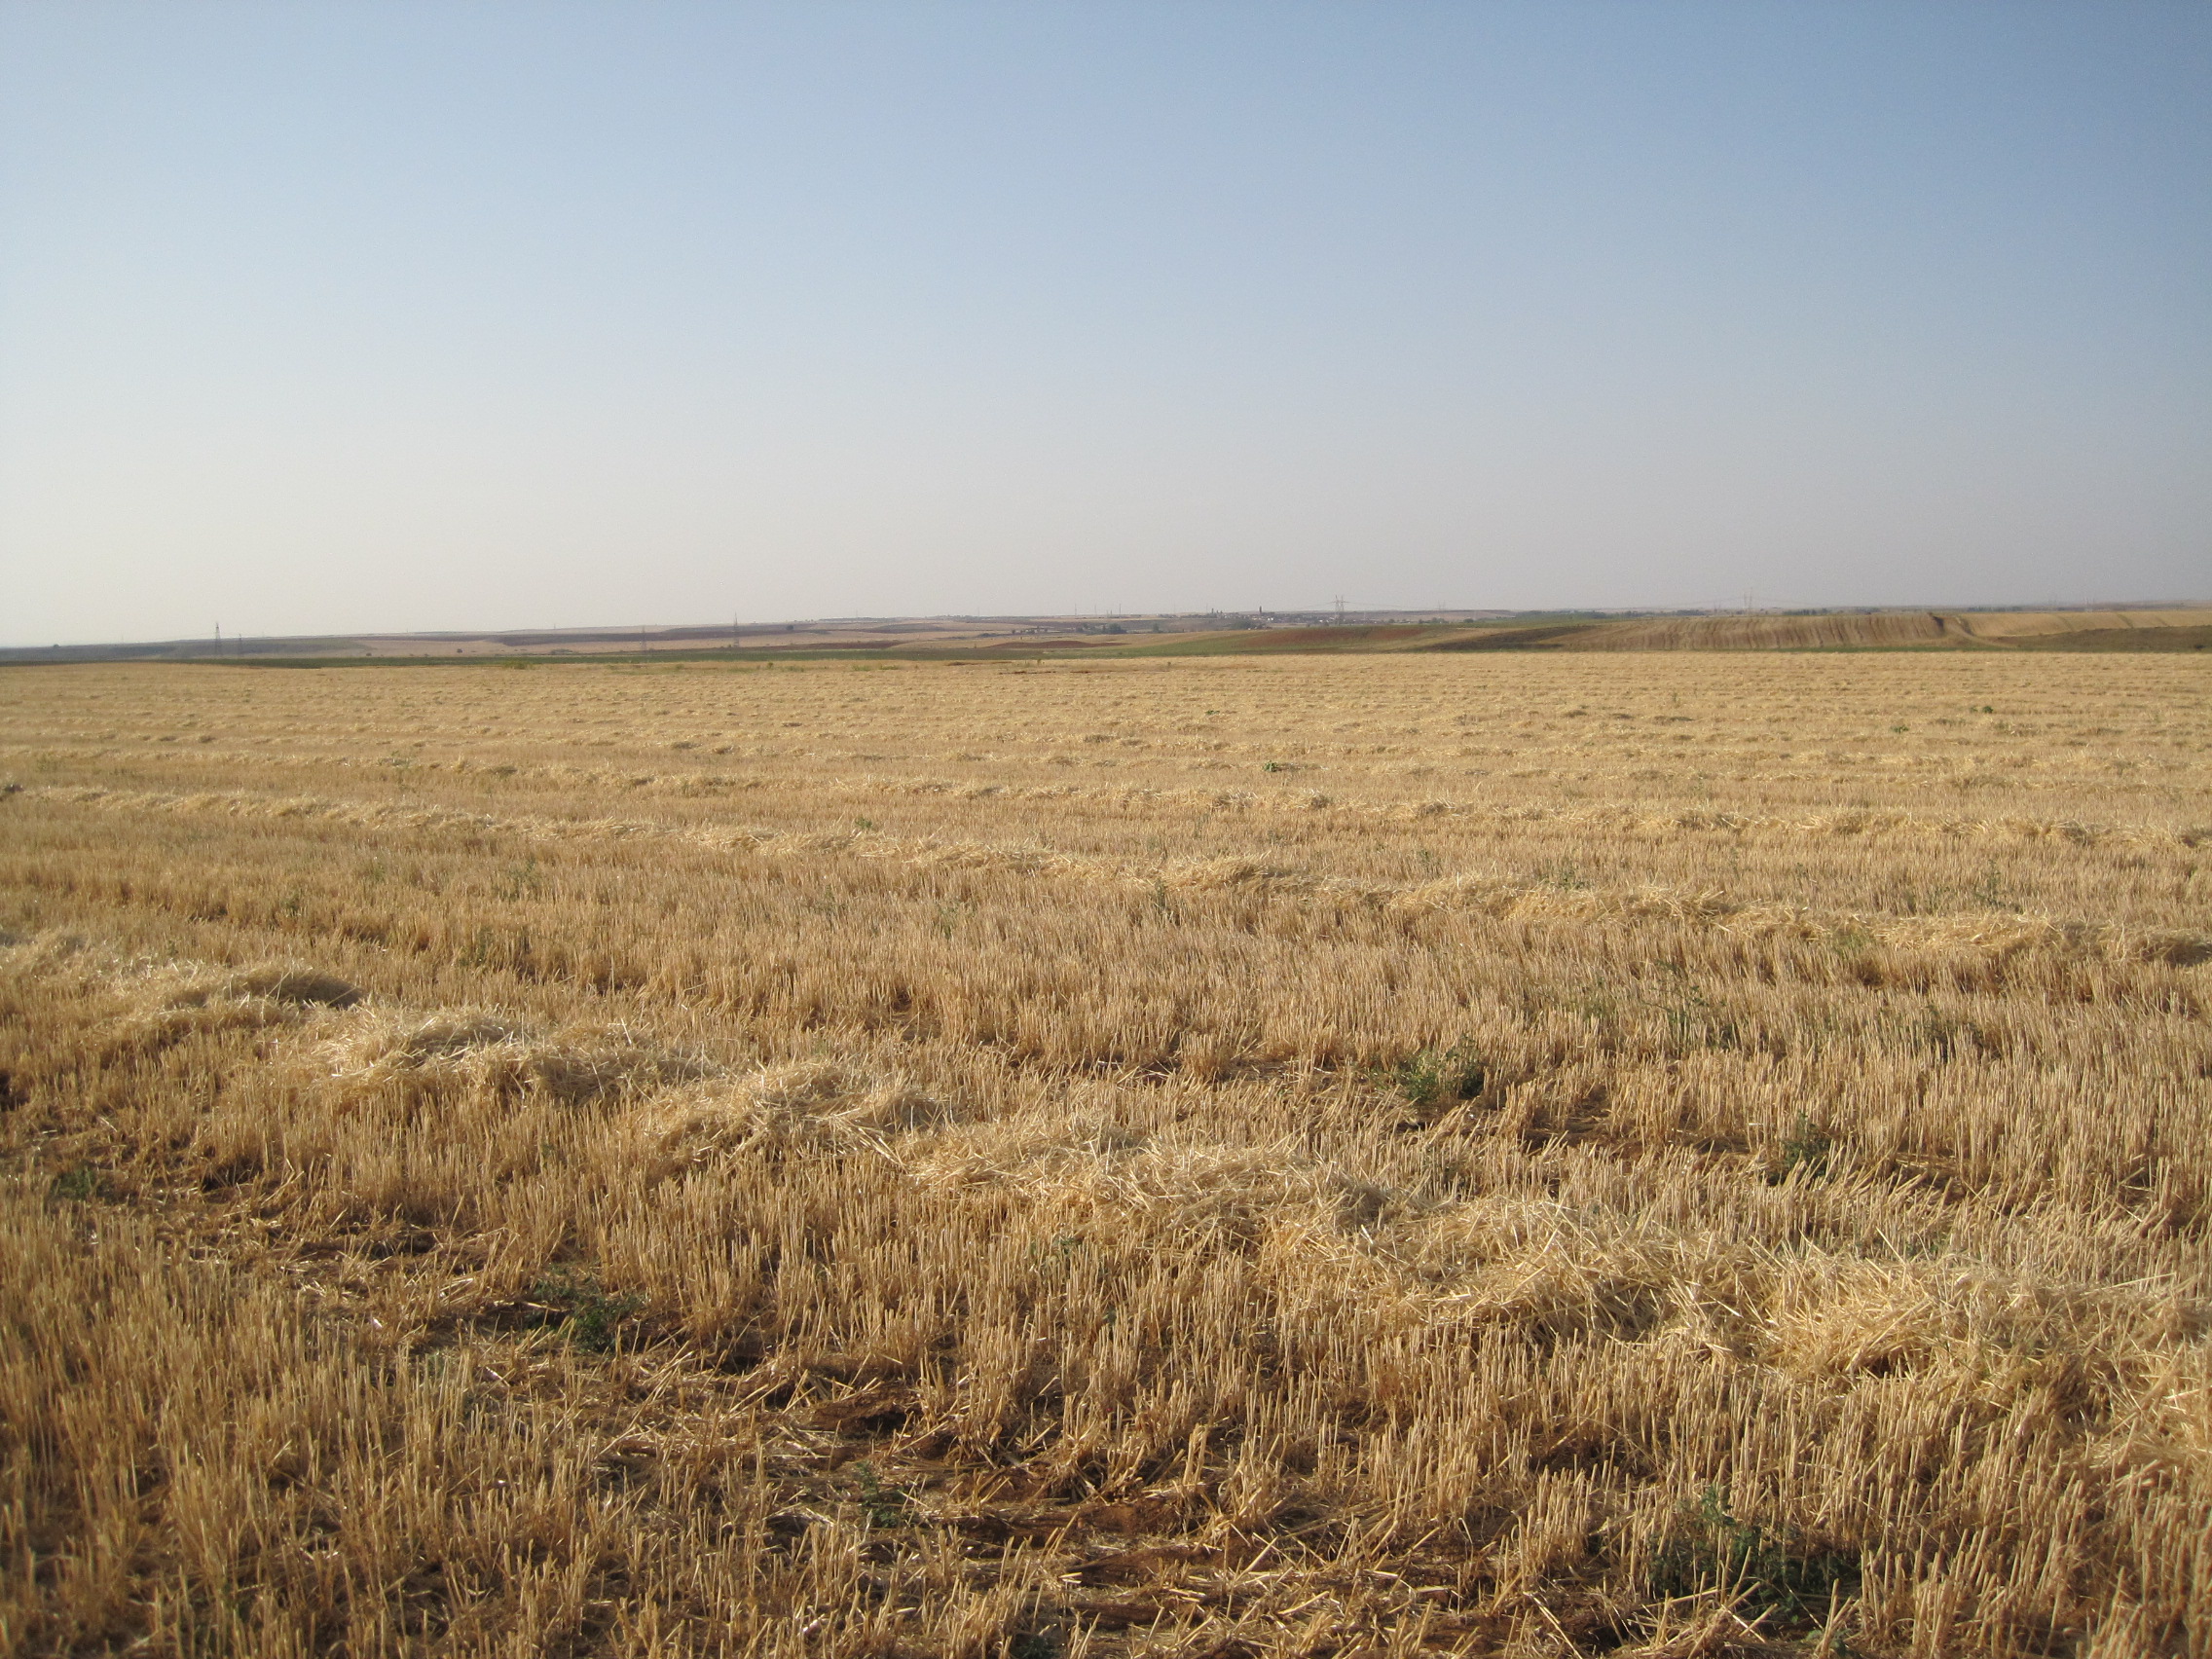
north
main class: Cropland
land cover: Barley
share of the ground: < 10 %
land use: Agriculture (excluding fallow land and kitchen gardens)
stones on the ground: 25 - 50 %
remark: Harvested field
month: July
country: ES
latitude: 41.6662
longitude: -5.5417
